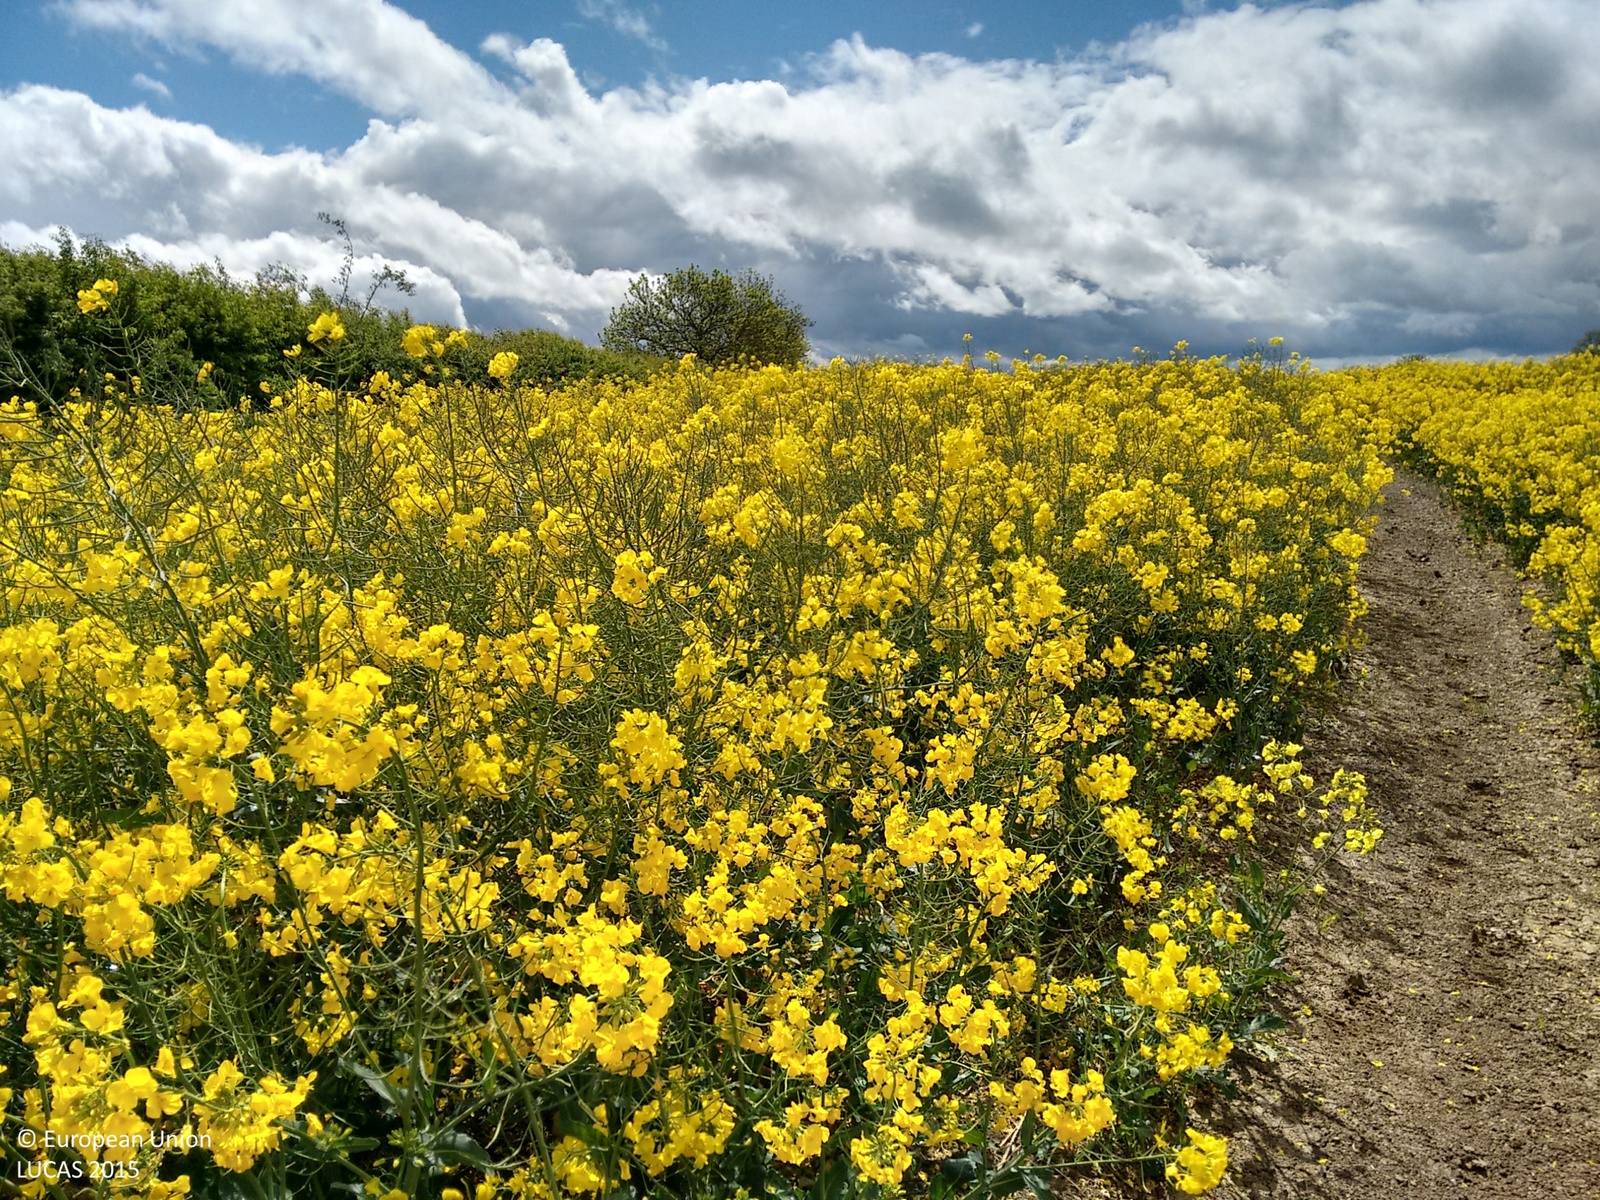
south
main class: Cropland
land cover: Rape and turnip rape
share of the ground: > 75 %
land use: Agriculture (excluding fallow land and kitchen gardens)
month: May
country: GB
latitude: 52.2756
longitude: -1.2597
